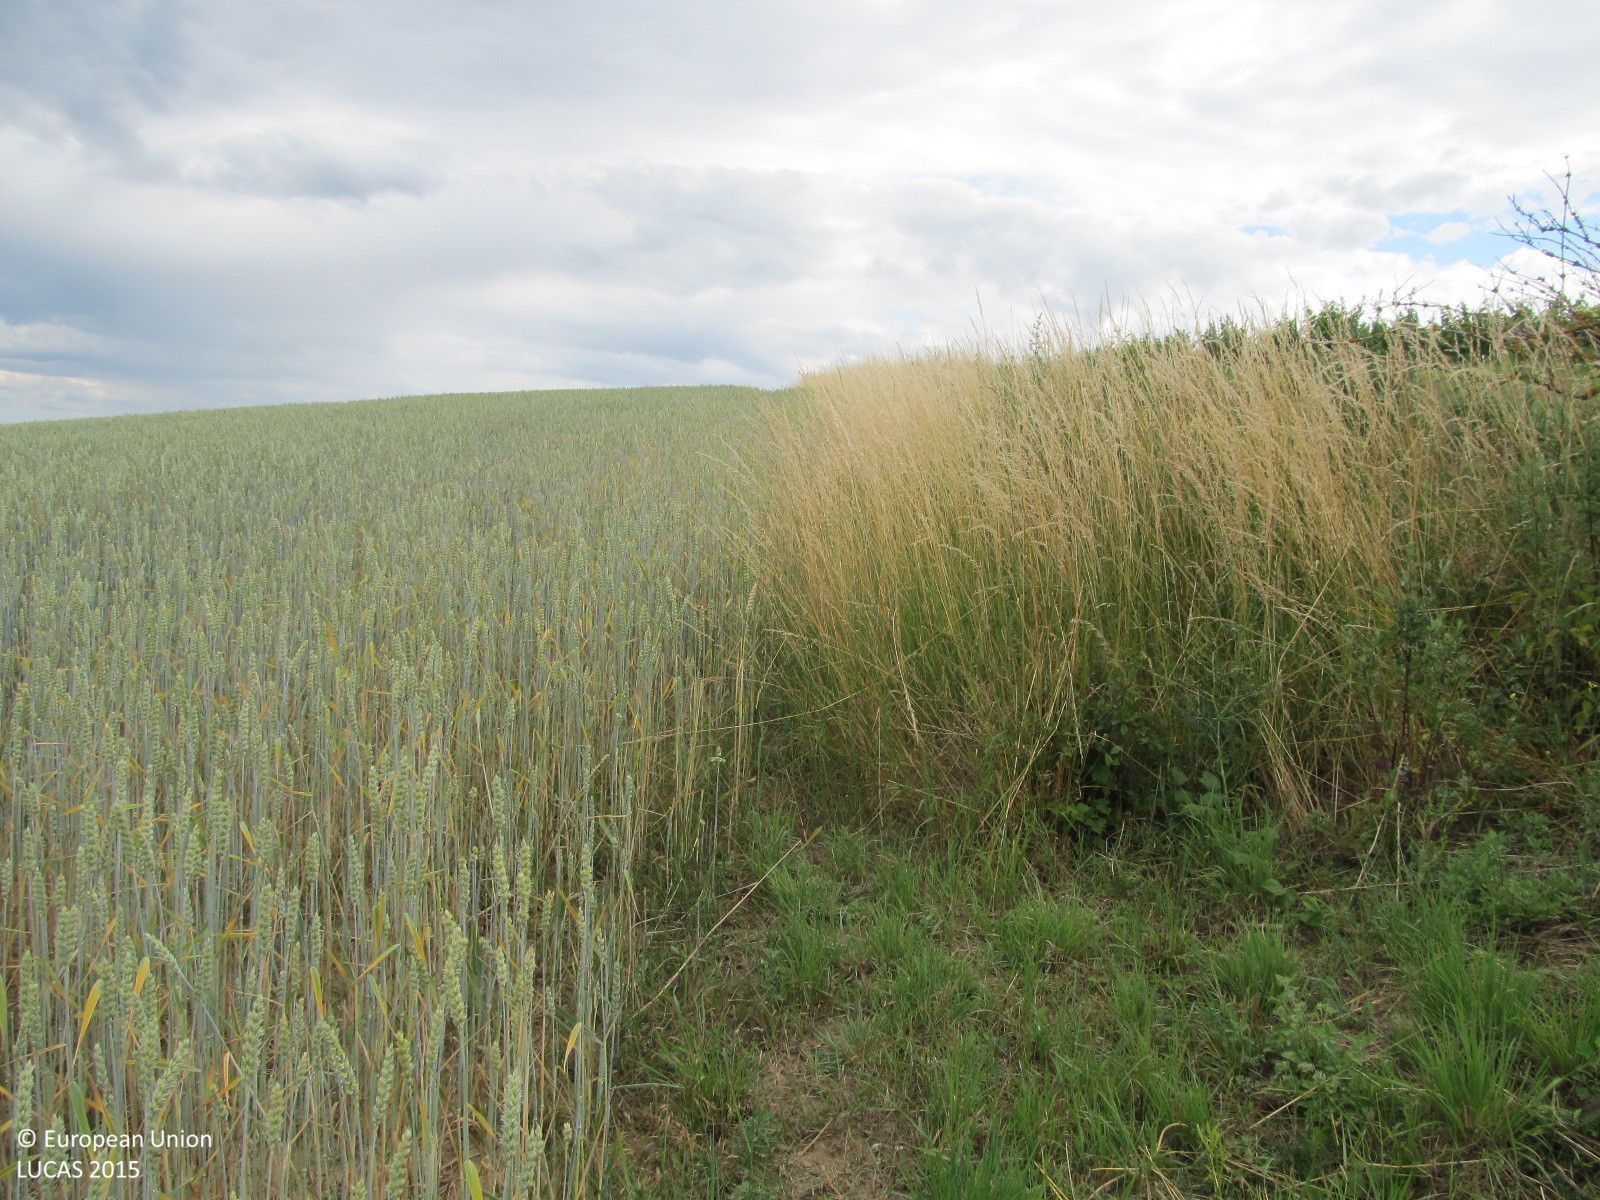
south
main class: Cropland
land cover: Common wheat
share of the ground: > 75 %
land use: Agriculture (excluding fallow land and kitchen gardens)
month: June
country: AT
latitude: 48.7367
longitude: 16.1647
